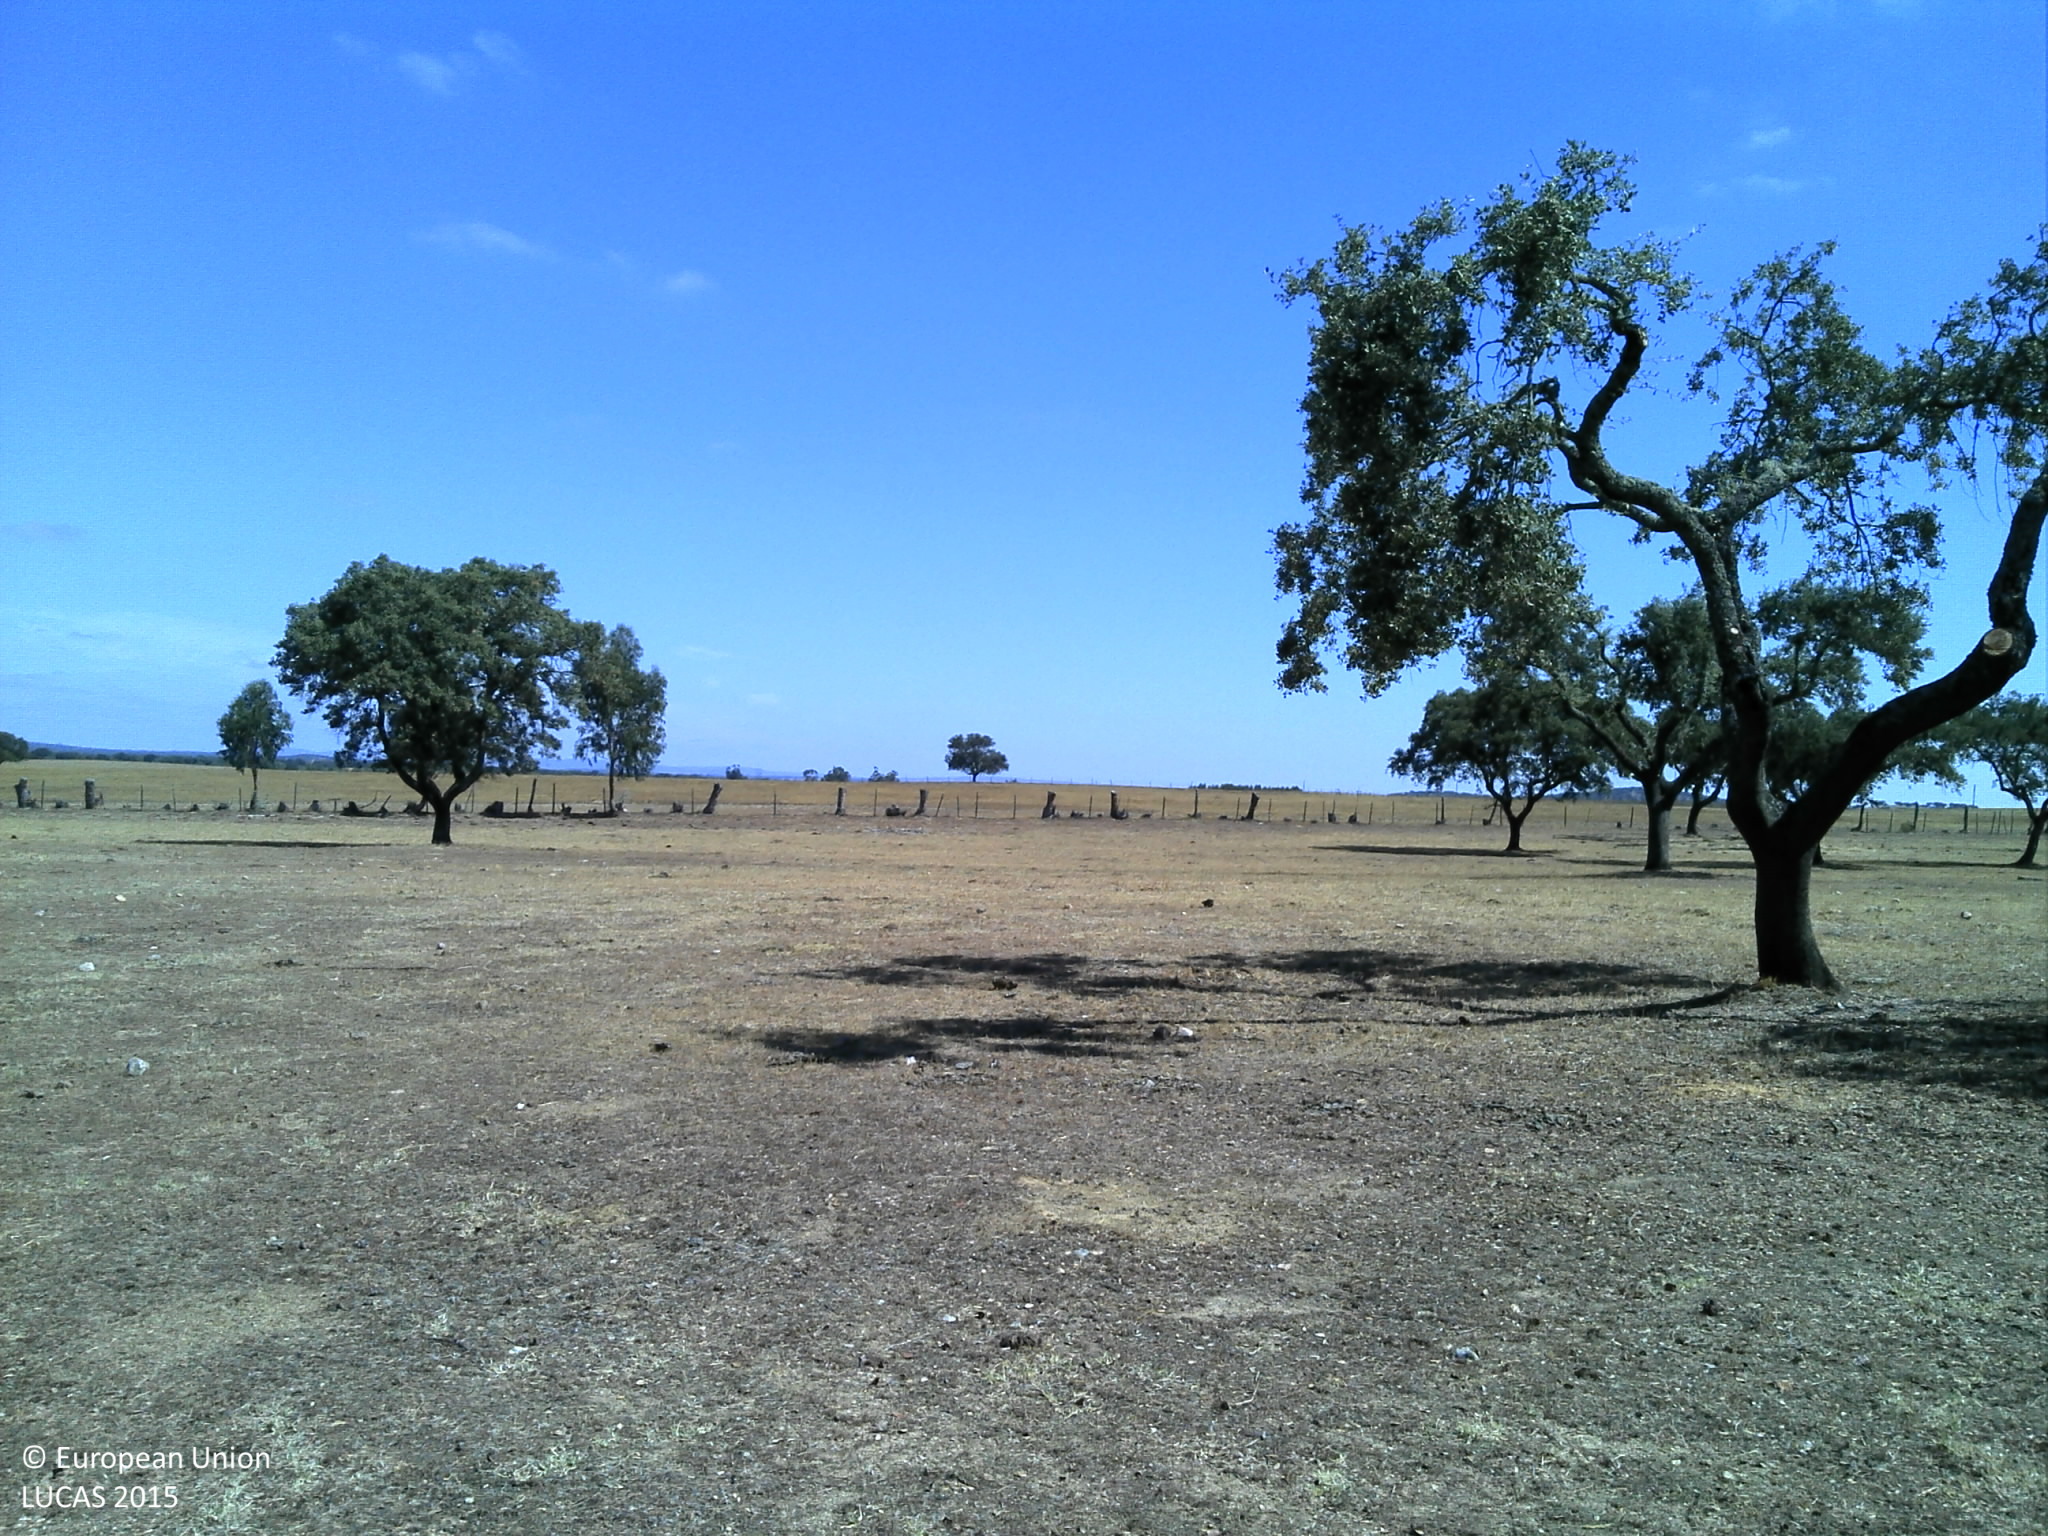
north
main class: Woodland
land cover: Broadleaved woodland
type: broadleaved evergreen forest
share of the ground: 10 - 25 %
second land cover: Grassland without tree/shrub cover
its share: < 10 %
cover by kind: unconsolidated bare surface 80 %, broadleaved forest trees 10 %, herbaceous plants 10 %
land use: Forestry
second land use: Agriculture (excluding fallow land and kitchen gardens)
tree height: > 5 m
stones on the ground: < 10 %
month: June
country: PT
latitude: 38.2963
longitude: -8.0699
